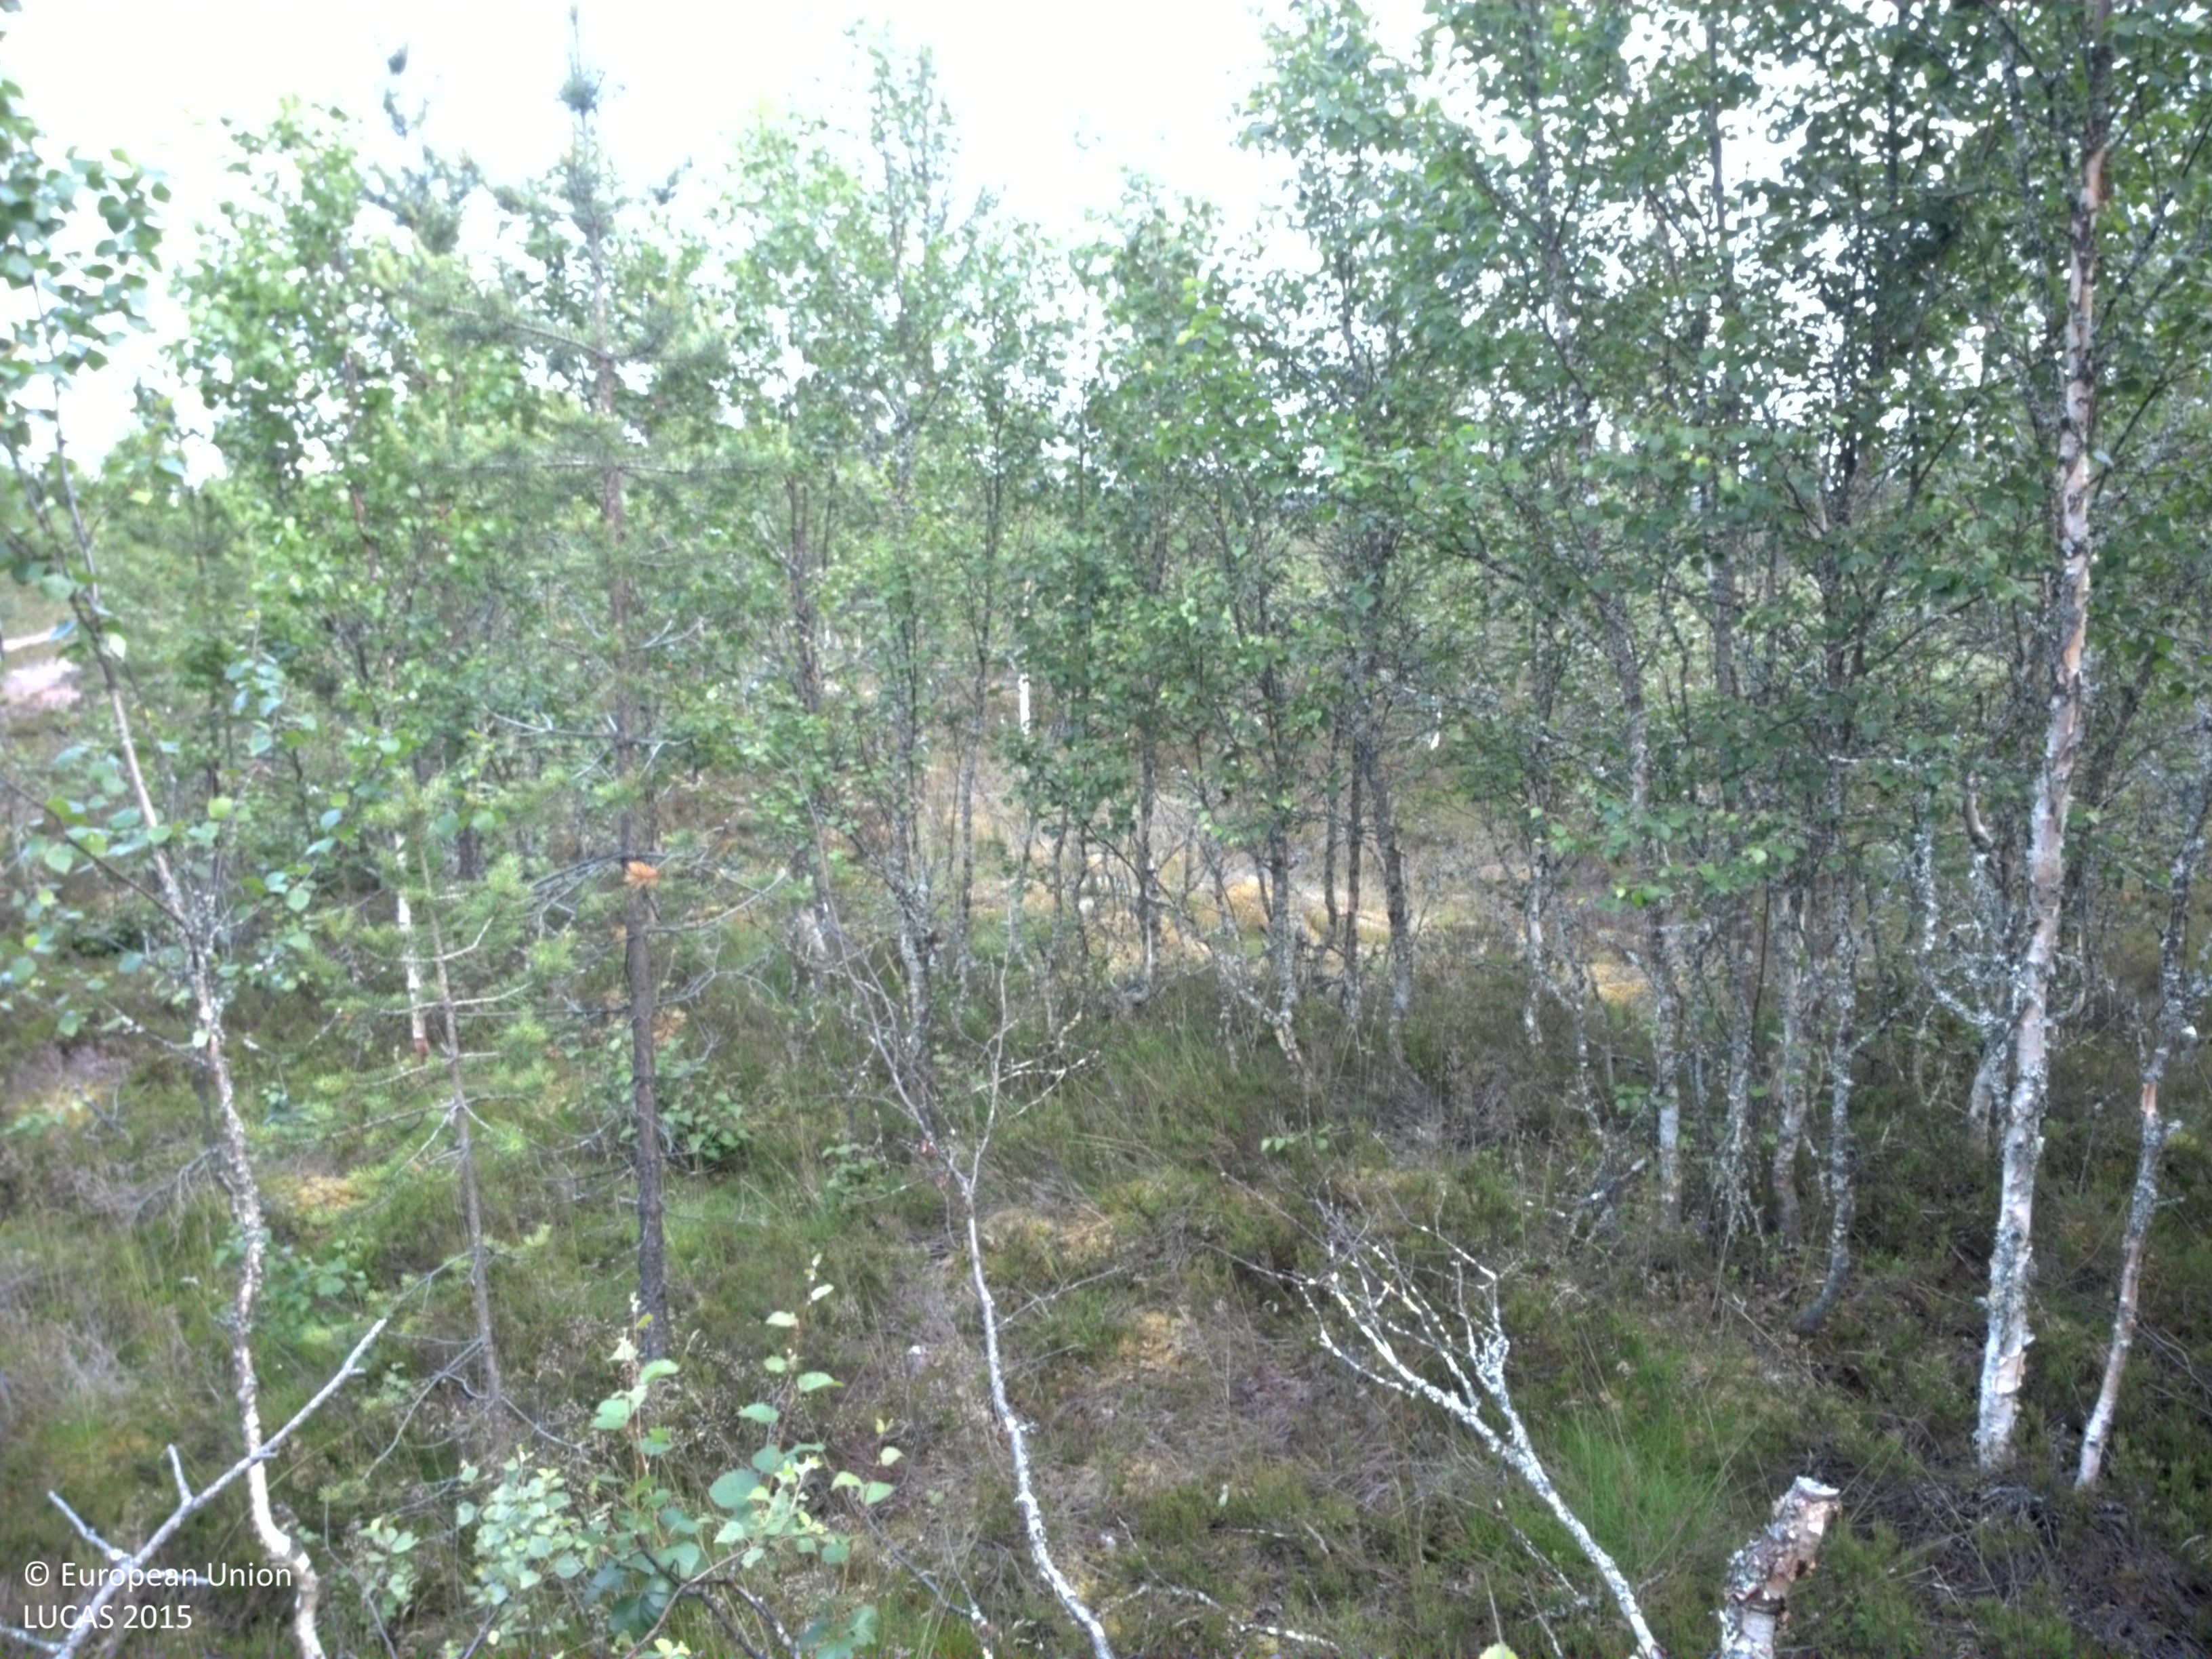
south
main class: Woodland
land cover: Broadleaved woodland
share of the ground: 50 - 75 %
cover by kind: broadleaved forest trees 70 %, shrubs 20 %, lichens and mosses 10 %
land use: Forestry
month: July
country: SE
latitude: 61.6115
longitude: 13.6631
